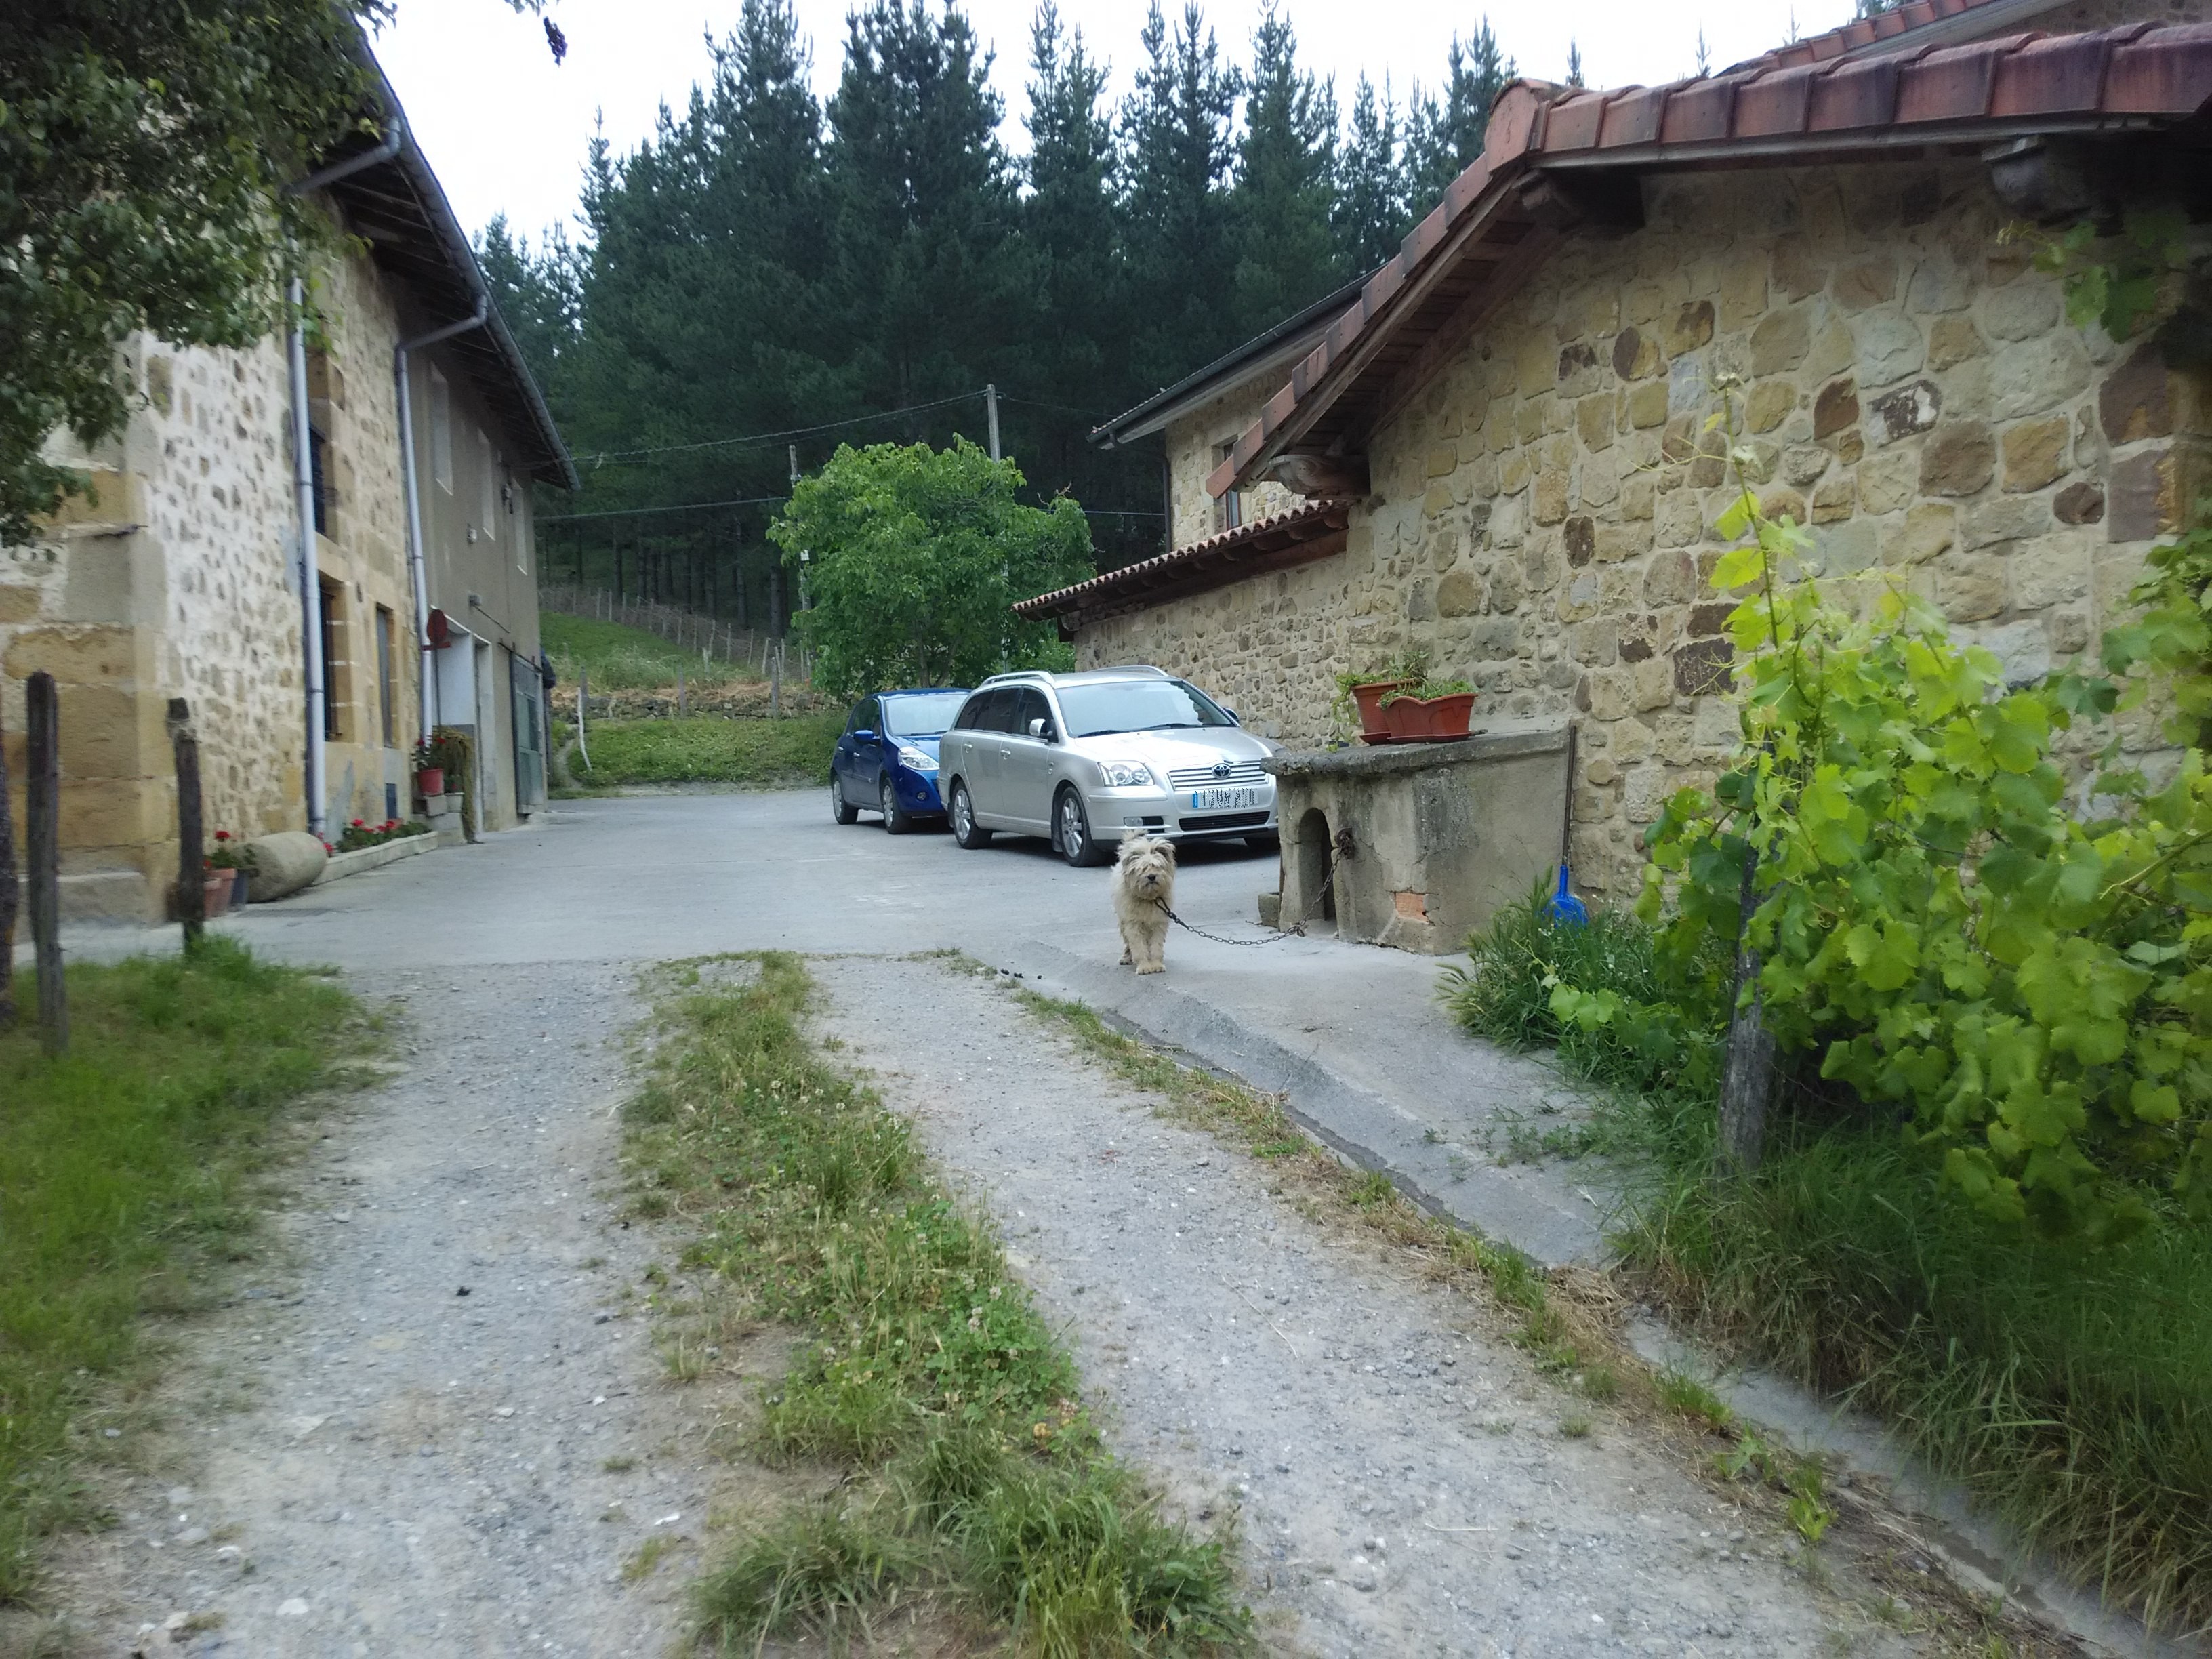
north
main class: Grassland
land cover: Grassland with sparse tree/shrub cover
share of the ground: 25 - 50 %
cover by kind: herbaceous plants 60 %, broadleaved forest trees 5 %, shrubs 5 %
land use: Agriculture (excluding fallow land and kitchen gardens)
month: June
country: ES
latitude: 43.1791
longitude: -2.5896
